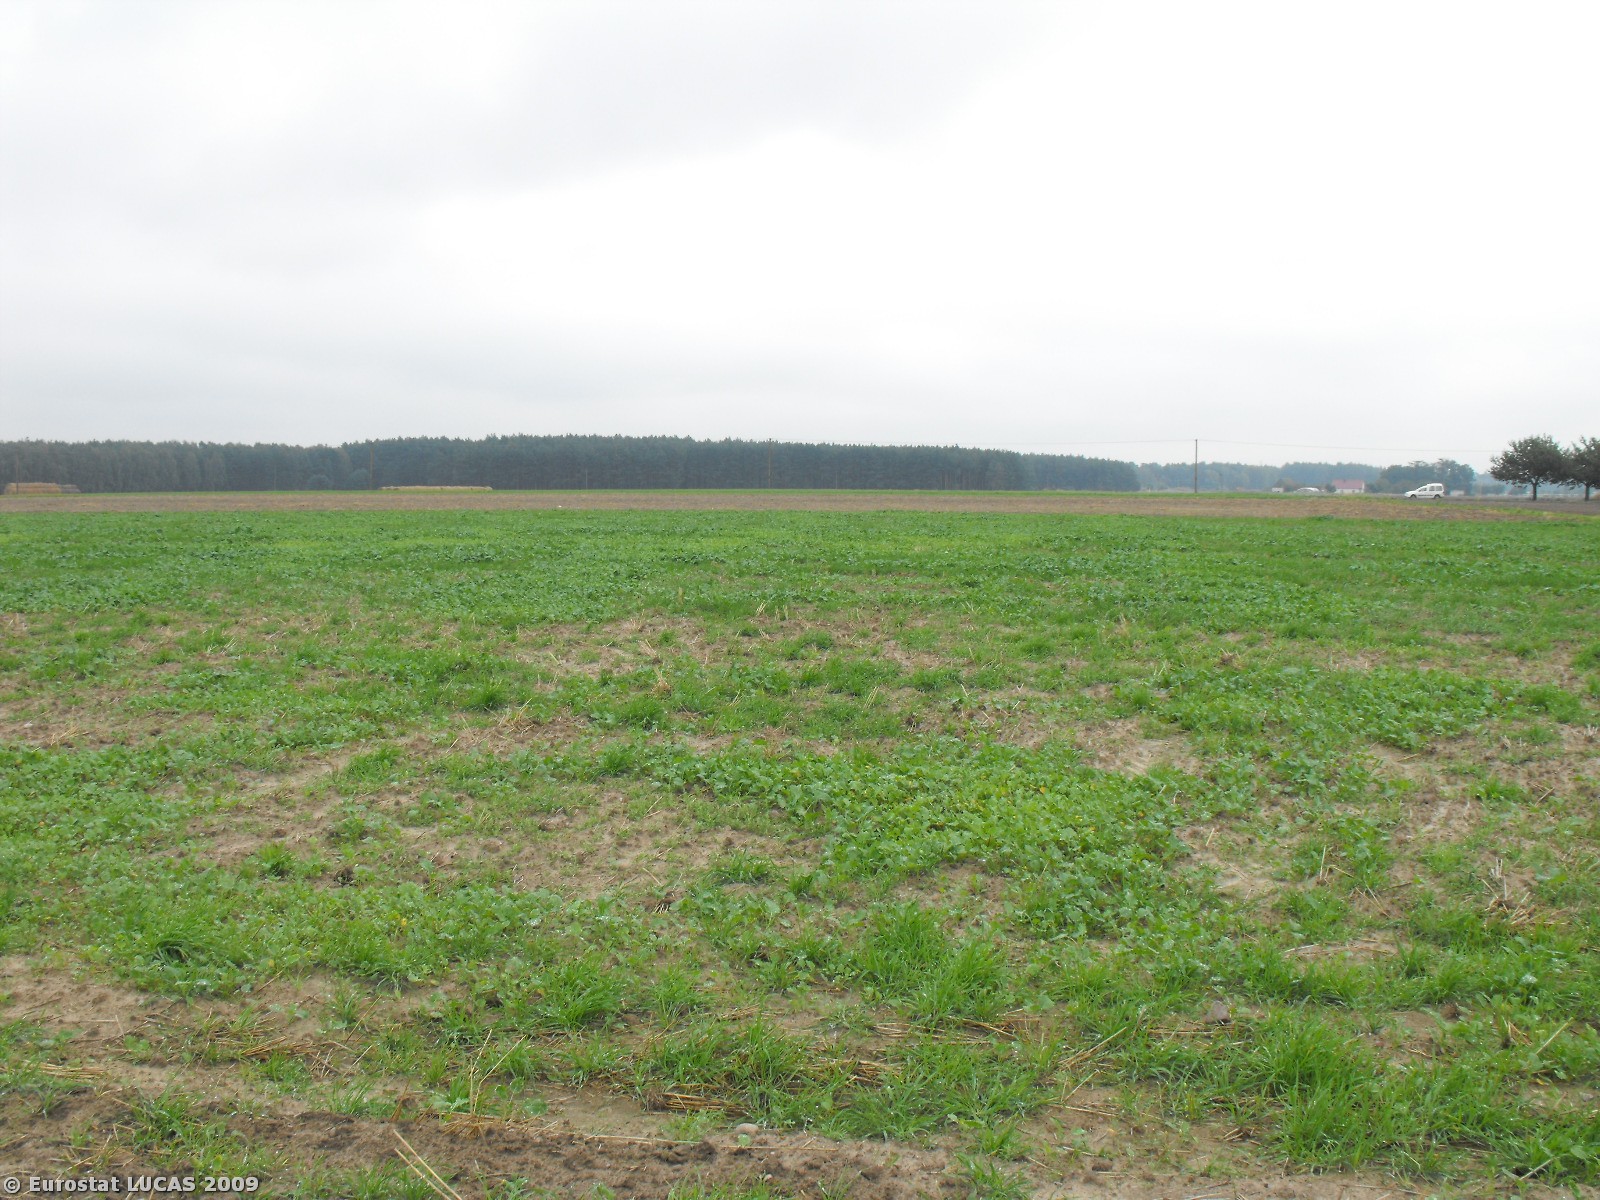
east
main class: Cropland
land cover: Barley
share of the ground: < 10 %
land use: Agriculture (excluding fallow land and kitchen gardens)
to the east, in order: Barley; Triticale; Potatoes; Grass margins; Tracks; Grass margins; Electric lines; Common wheat
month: September
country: PL
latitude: 52.2615
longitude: 16.3511
